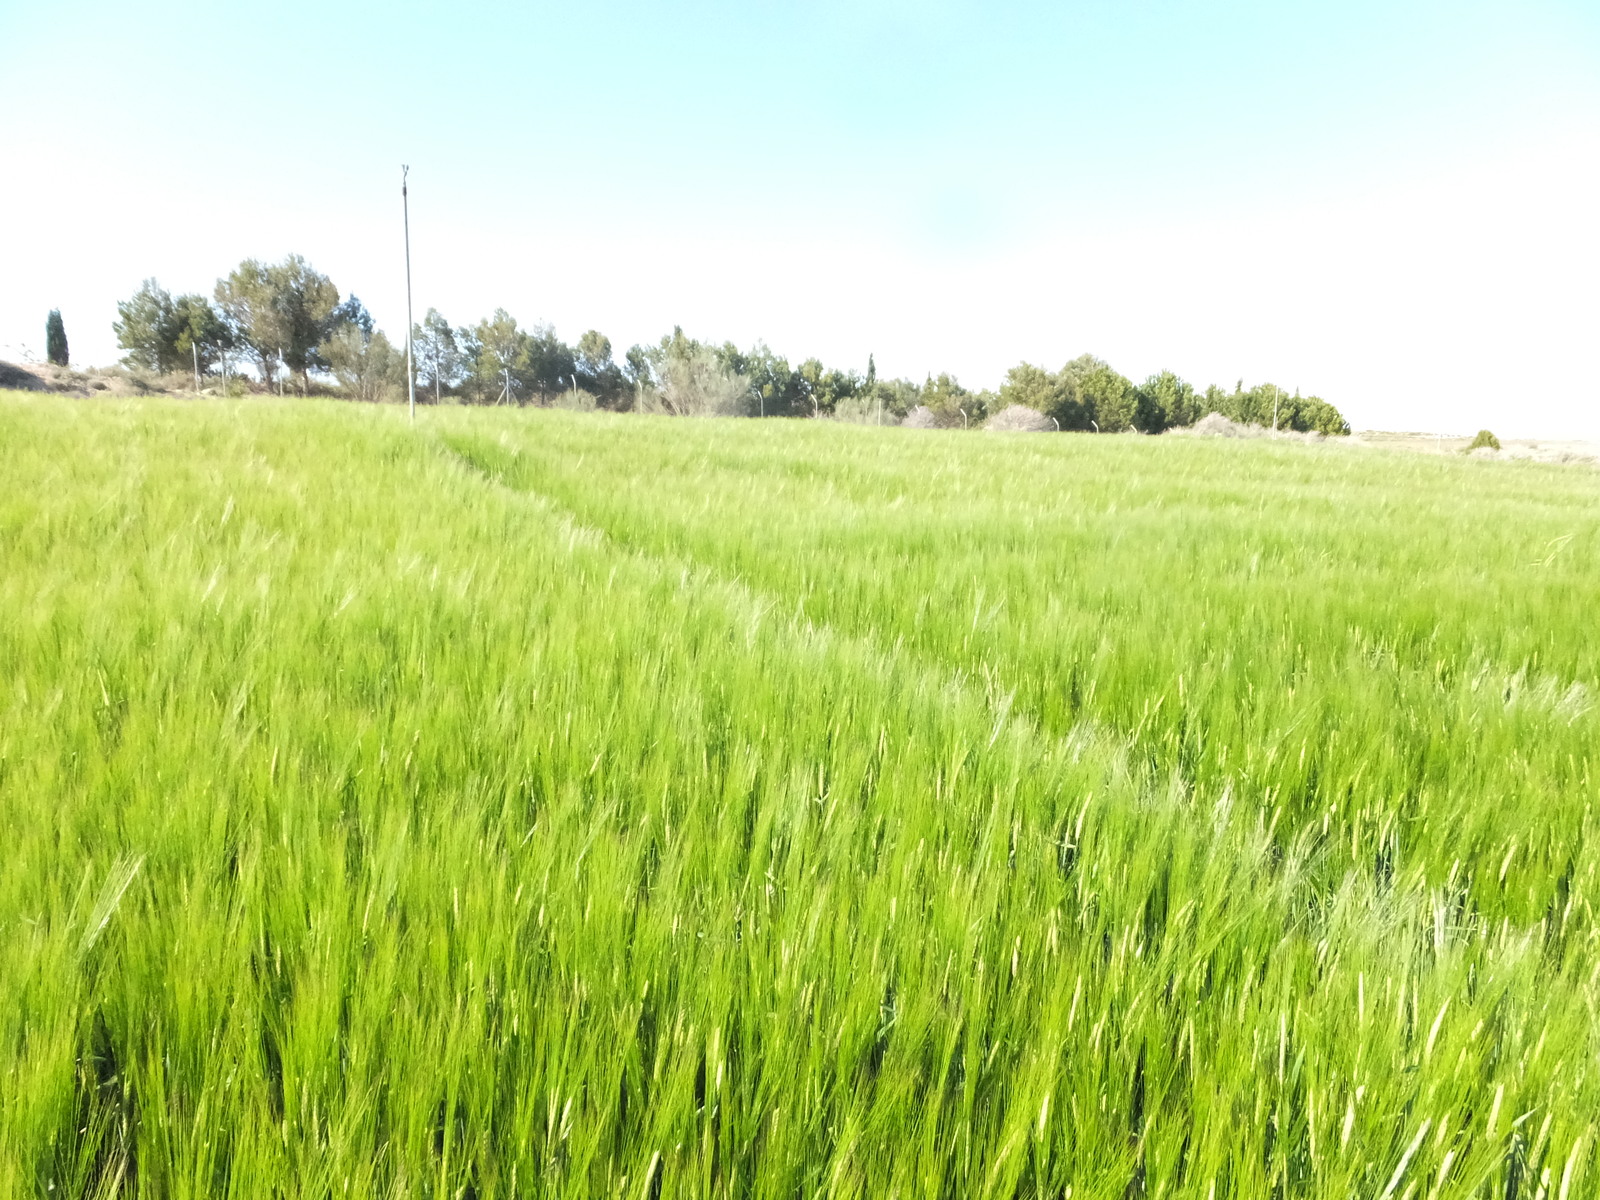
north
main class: Cropland
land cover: Barley
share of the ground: > 75 %
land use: Agriculture (excluding fallow land and kitchen gardens)
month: April
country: ES
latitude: 41.6967
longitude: -0.2432
